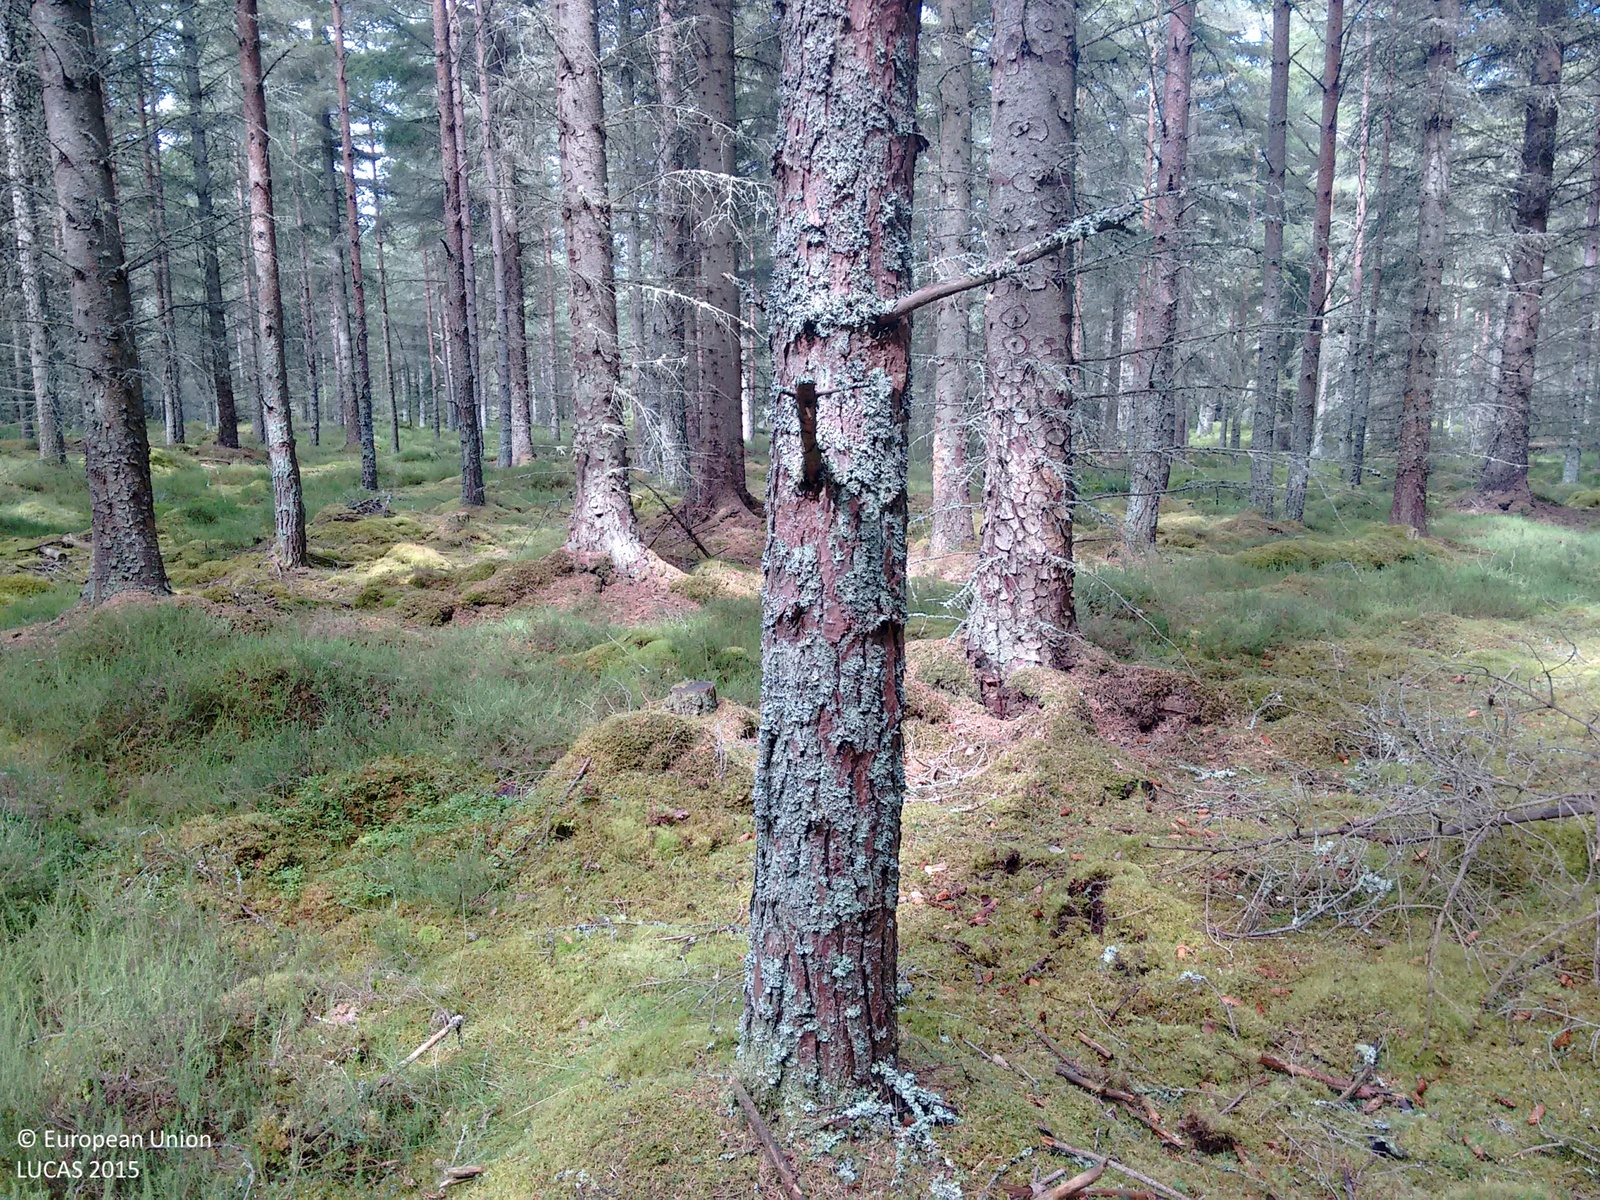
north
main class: Woodland
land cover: Spruce dominated coniferous woodland
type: exotic forest
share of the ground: > 75 %
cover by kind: coniferous forest trees 80 %, lichens and mosses 15 %, broadleaved forest trees 5 %
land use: Forestry
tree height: > 5 m
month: August
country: GB
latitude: 57.6723
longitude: -2.8504
